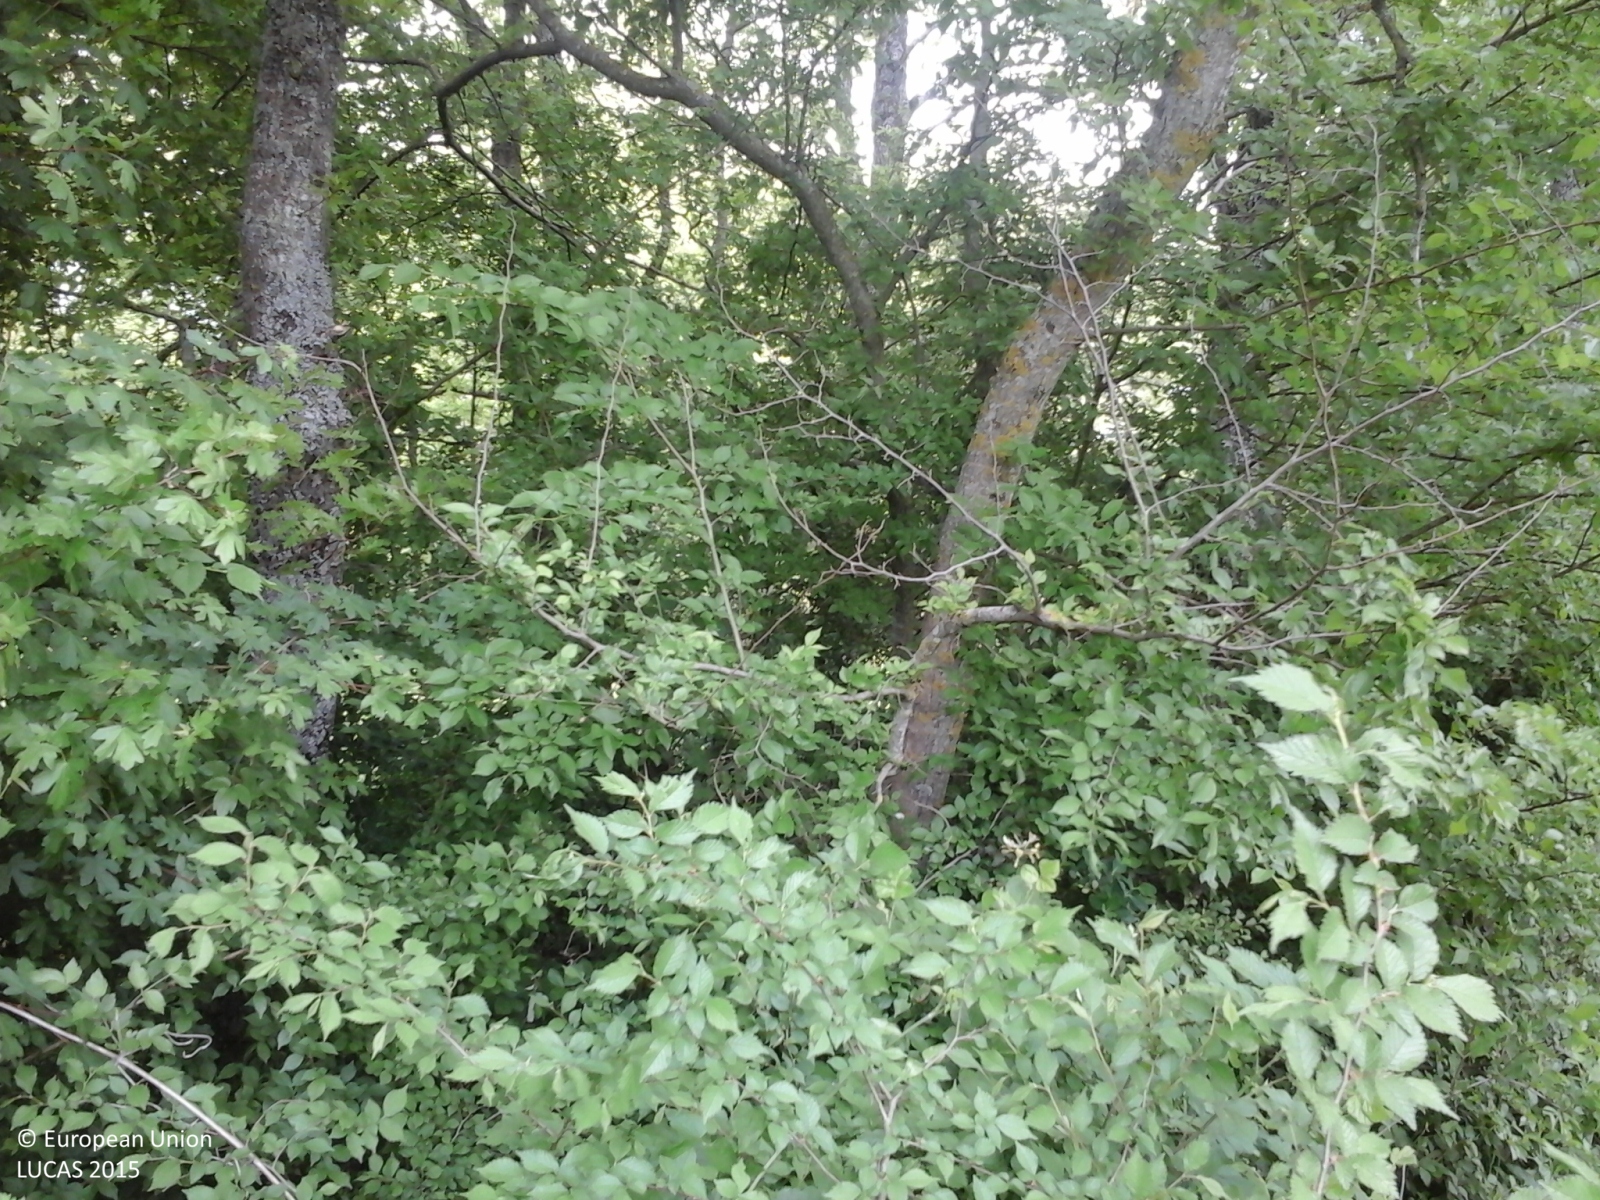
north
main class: Woodland
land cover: Broadleaved woodland
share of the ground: > 75 %
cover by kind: broadleaved forest trees 80 %, shrubs 20 %
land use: Forestry
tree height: > 5 m
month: May
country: IT
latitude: 41.3864
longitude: 14.7067
